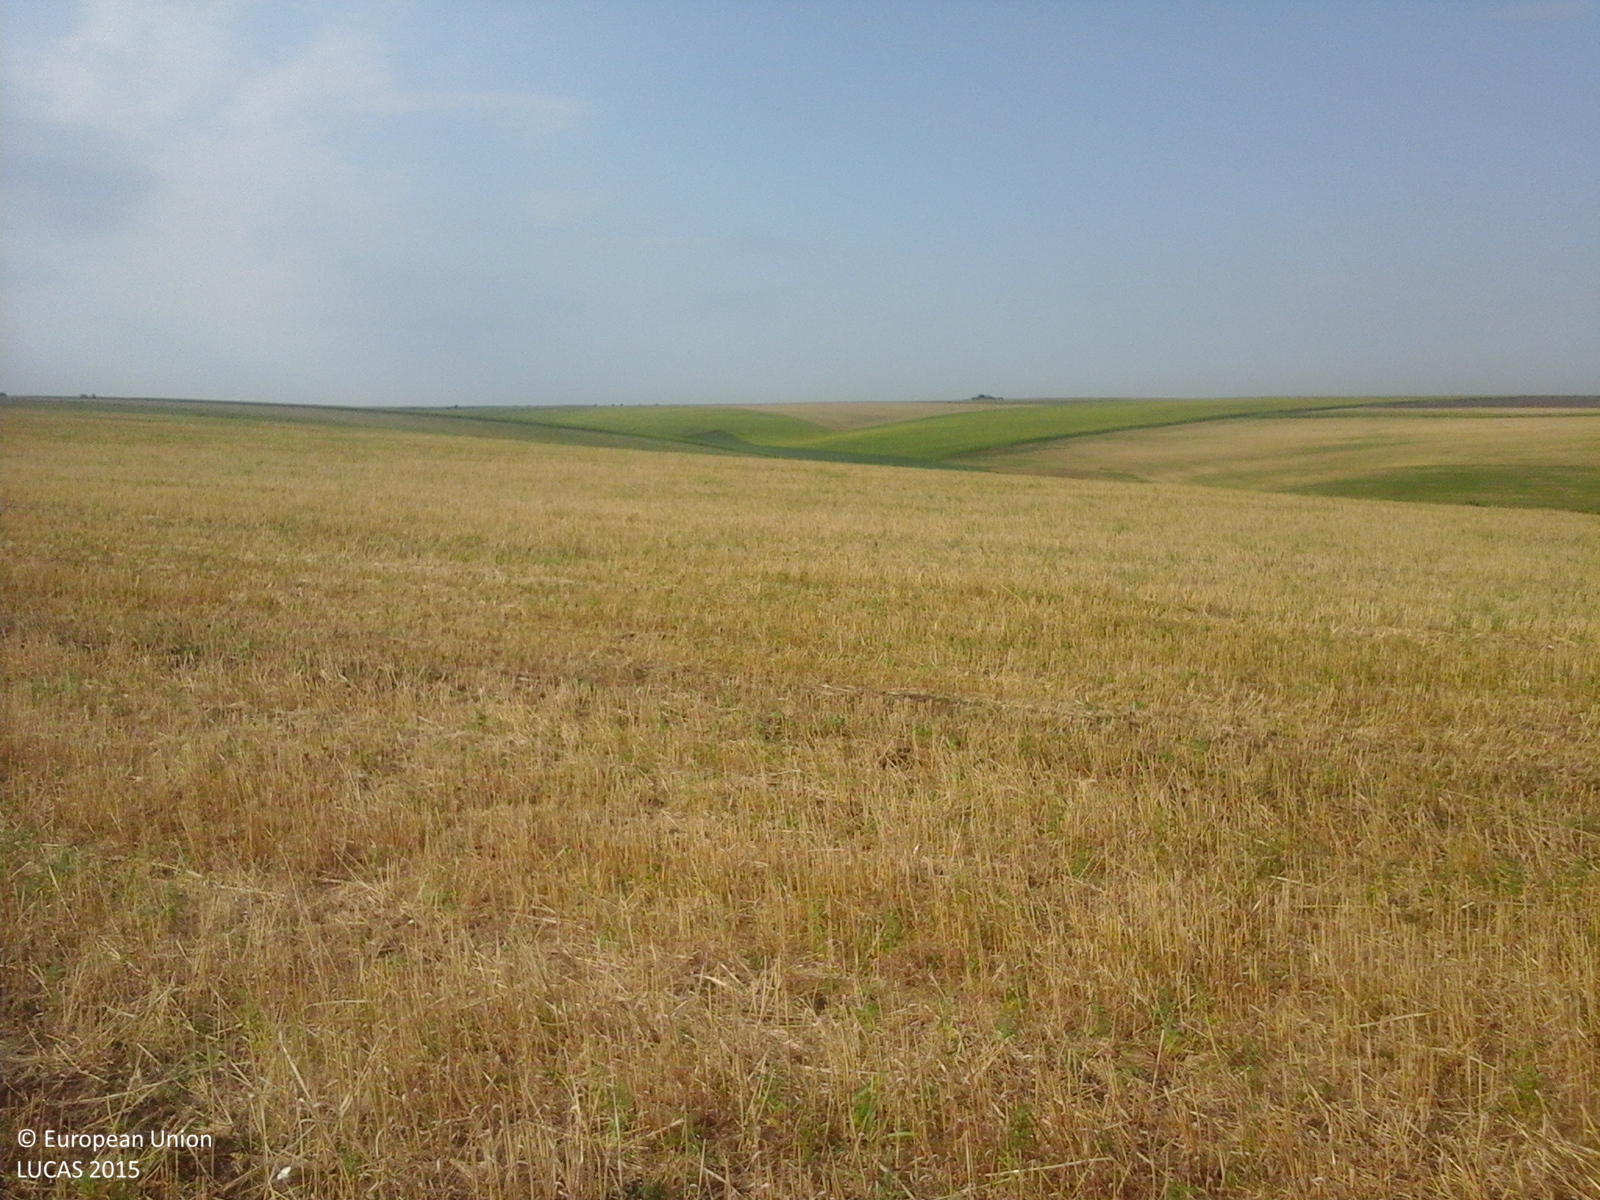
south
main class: Cropland
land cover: Barley
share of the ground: 50 - 75 %
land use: Agriculture (excluding fallow land and kitchen gardens)
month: August
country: RO
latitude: 44.0316
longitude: 27.9049
